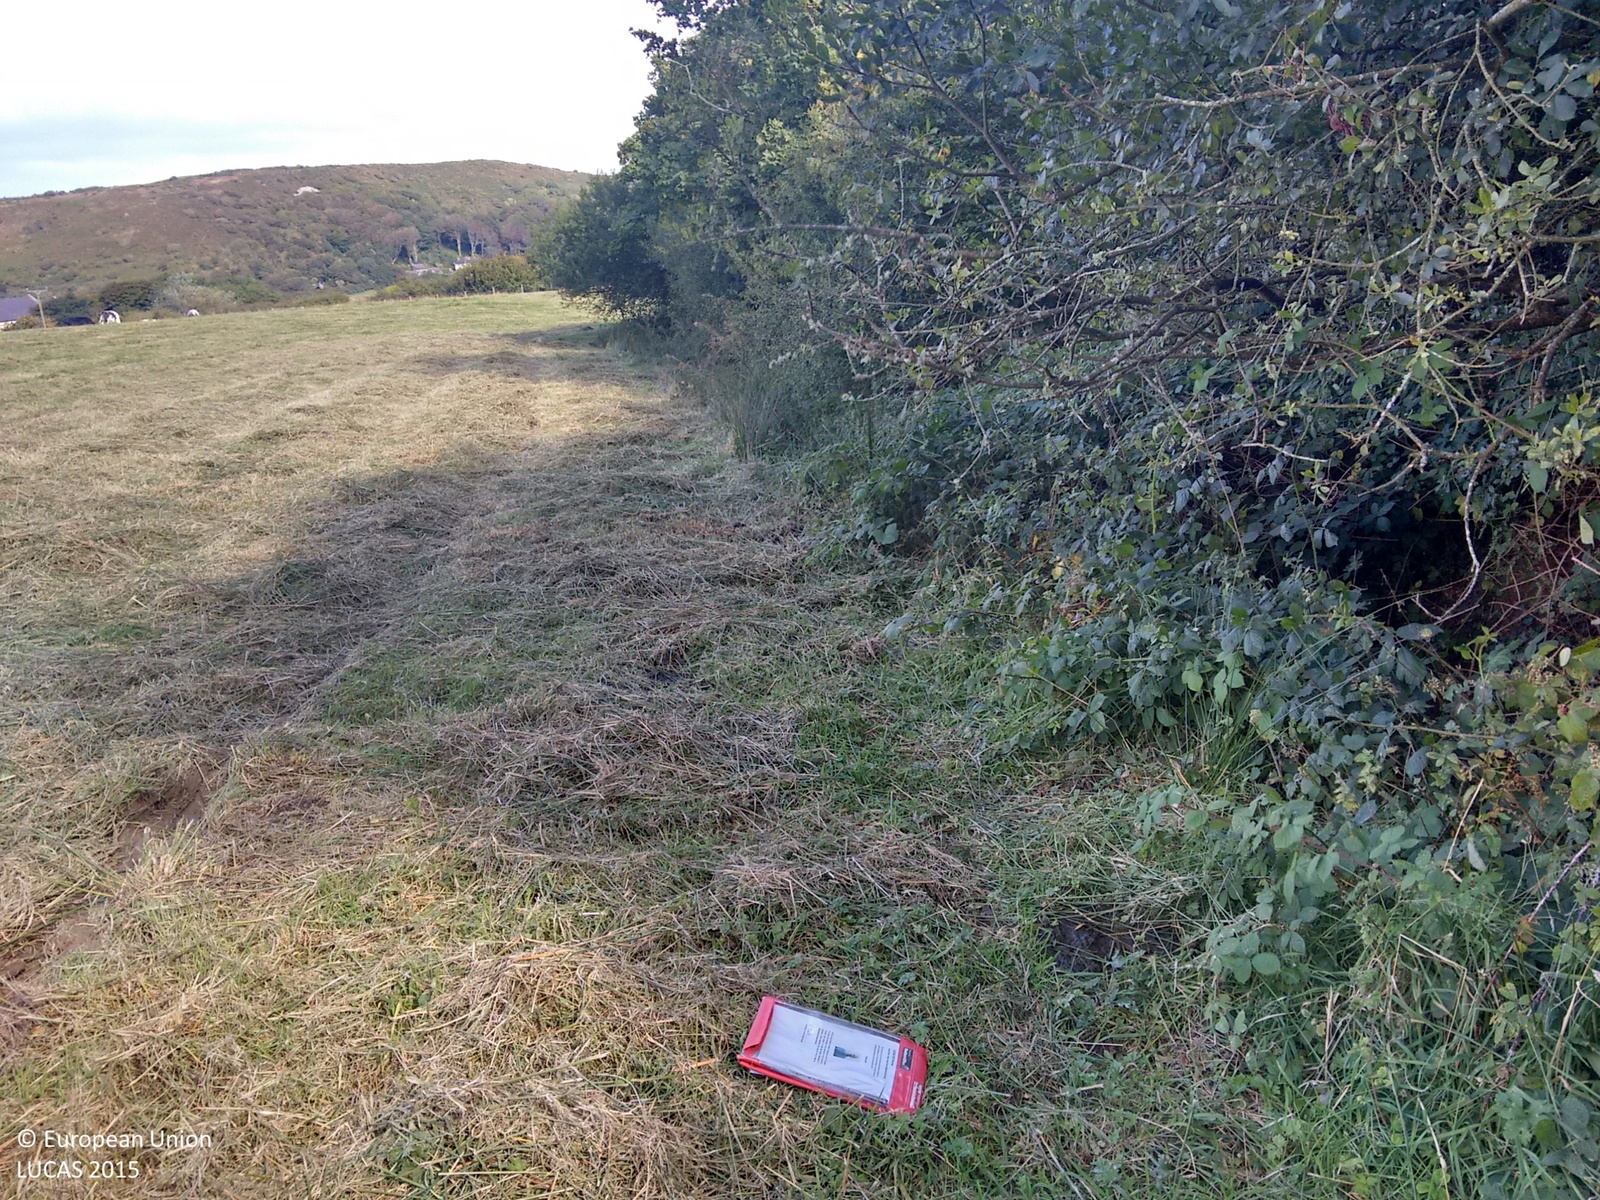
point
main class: Grassland
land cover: Grassland without tree/shrub cover
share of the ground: > 75 %
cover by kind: herbaceous plants 100 %
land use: Agriculture (excluding fallow land and kitchen gardens)
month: September
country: GB
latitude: 52.1391
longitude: -4.4975
